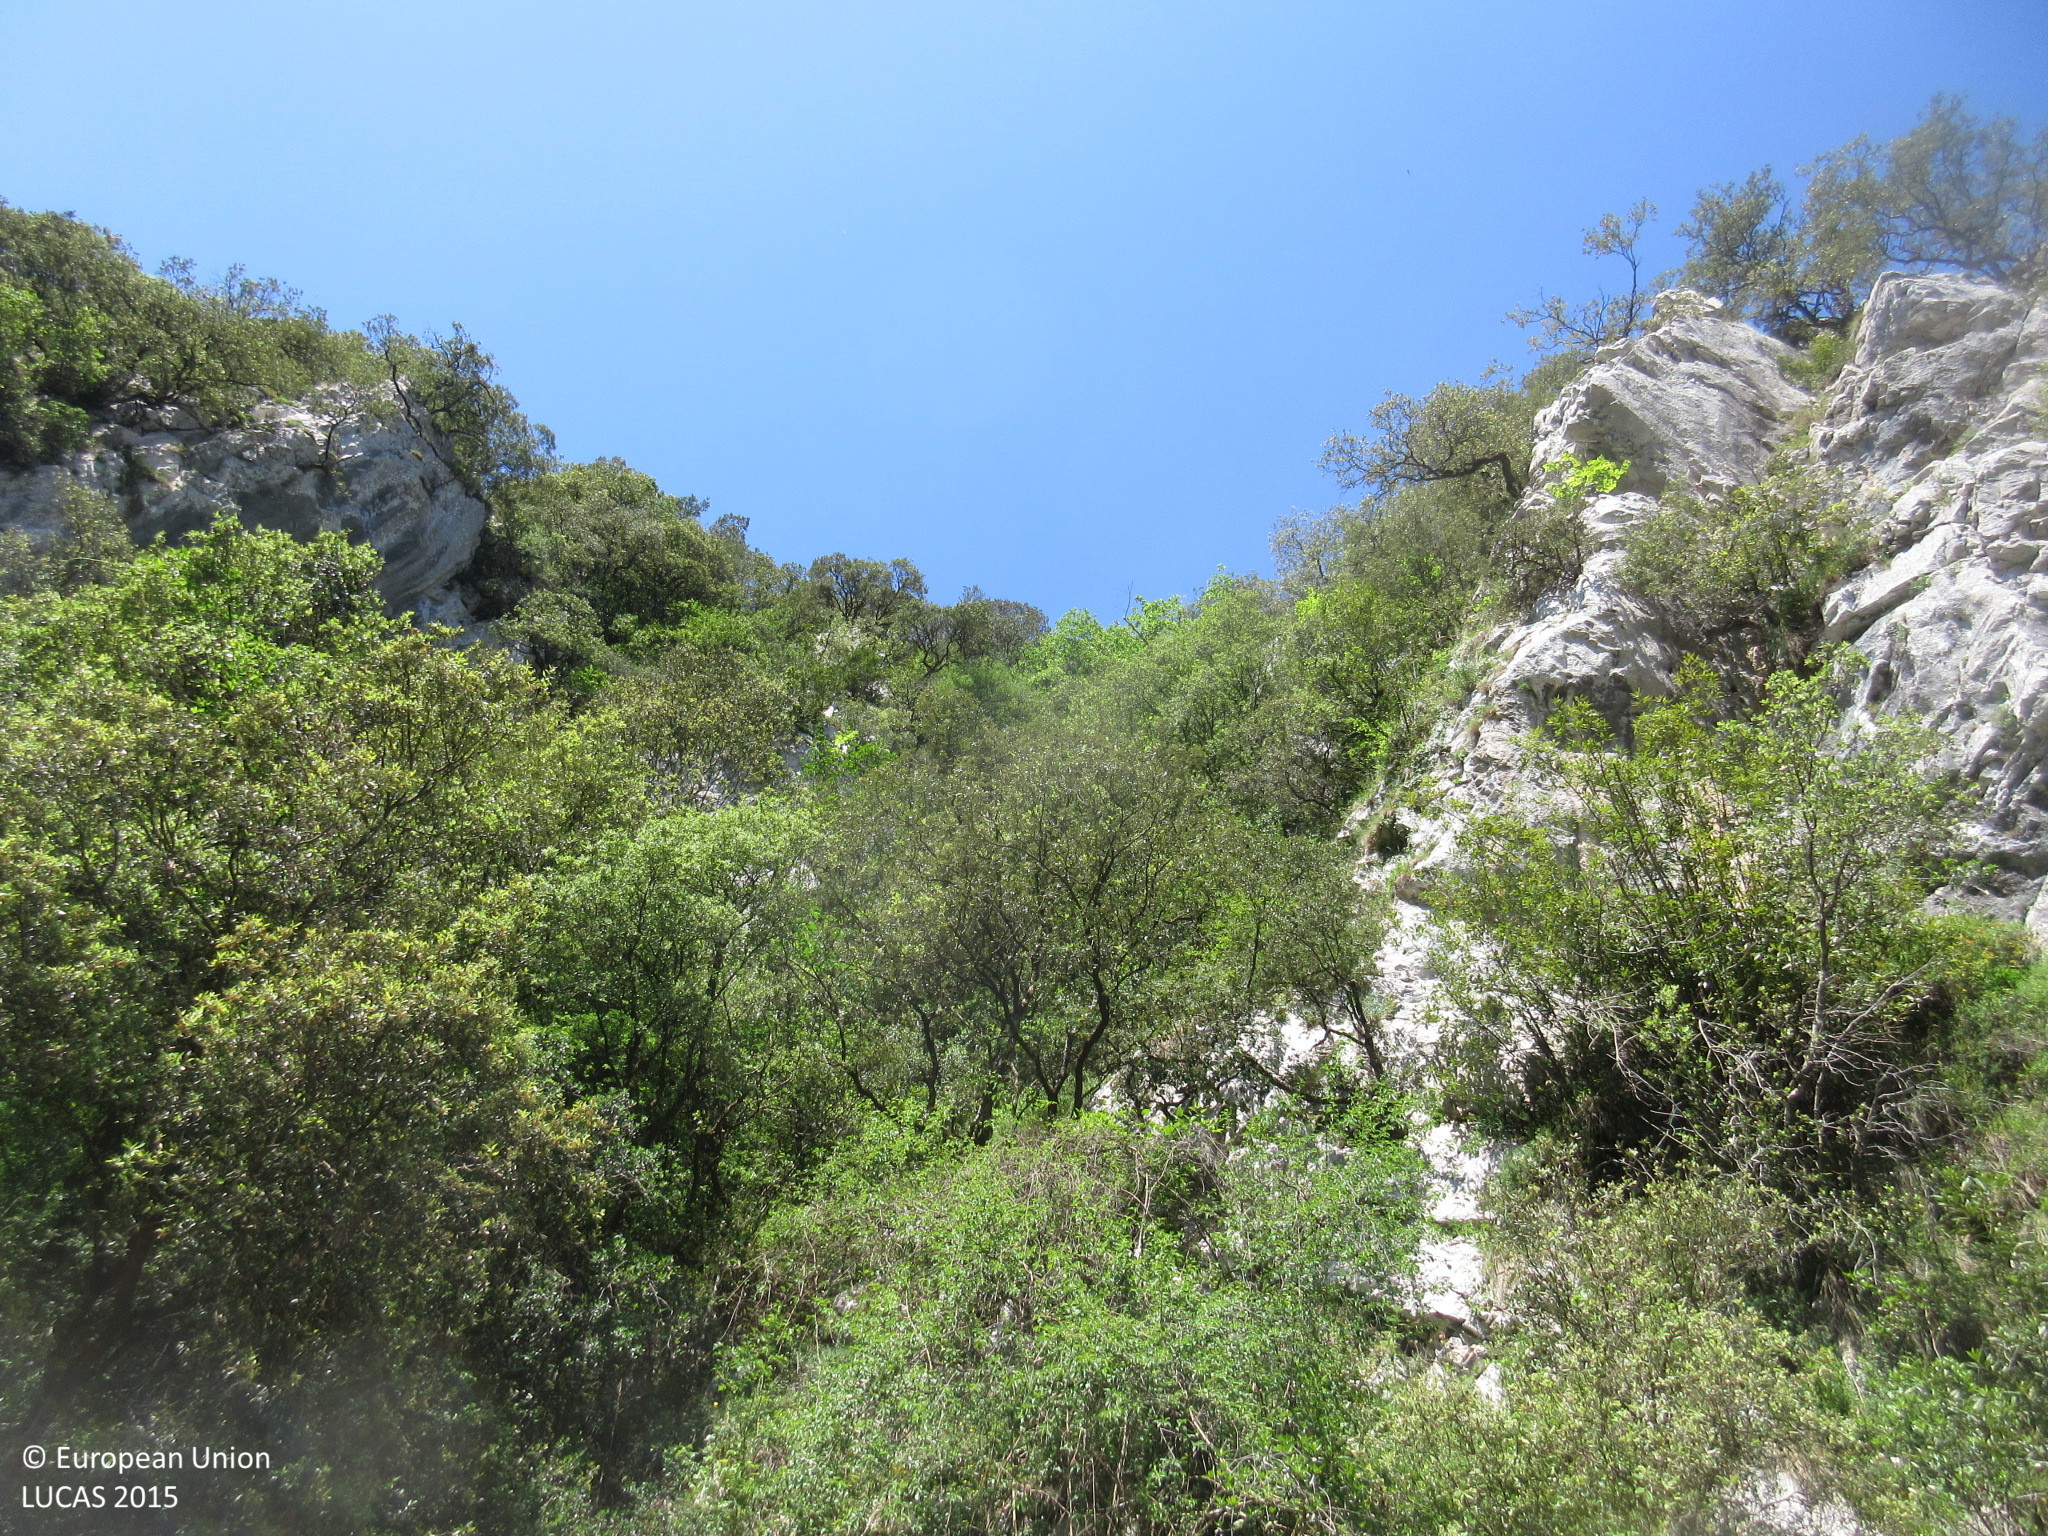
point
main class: Woodland
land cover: Broadleaved woodland
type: broadleaved evergreen forest
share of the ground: > 75 %
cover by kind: broadleaved forest trees 90 %, shrubs 5 %, herbaceous plants 5 %
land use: Semi-natural and natural areas not in use
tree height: > 5 m
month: May
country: ES
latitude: 43.2726
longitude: -4.4874
